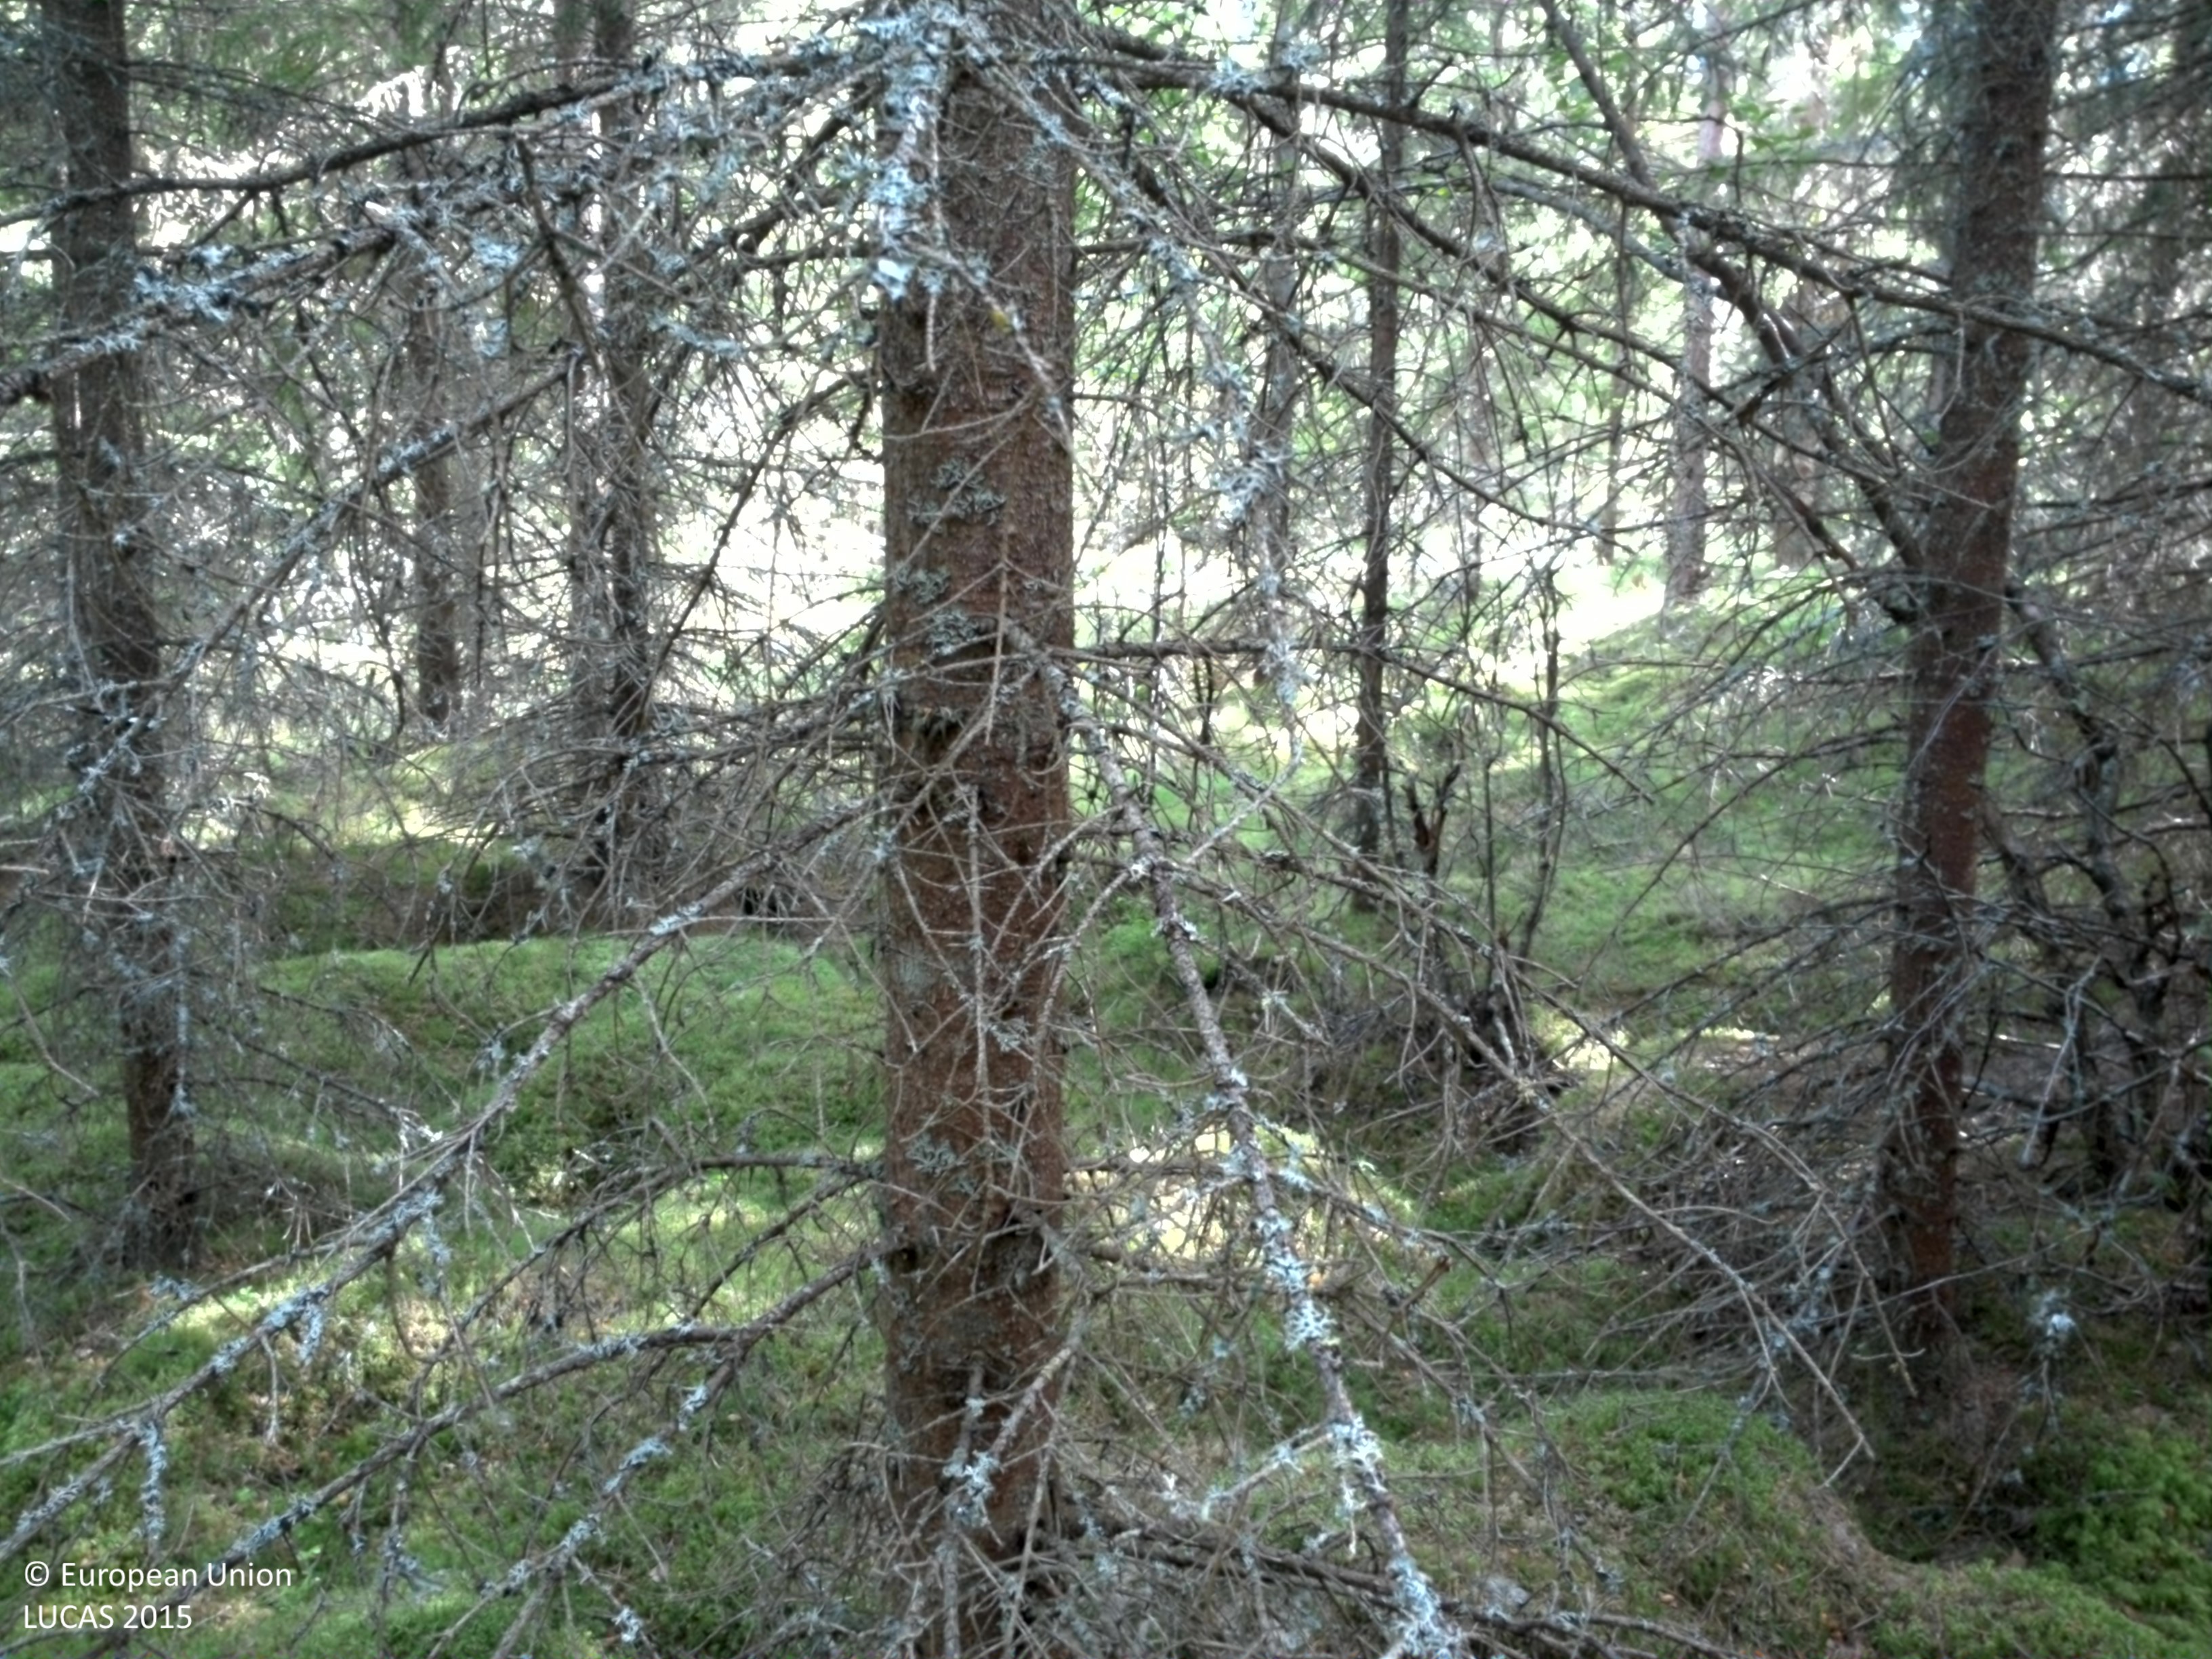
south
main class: Woodland
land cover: Spruce dominated coniferous woodland
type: boreal forest
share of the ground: > 75 %
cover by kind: coniferous forest trees 75 %, lichens and mosses 15 %, broadleaved forest trees 5 %, herbaceous plants 5 %
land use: Forestry
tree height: > 5 m
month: June
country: SE
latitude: 59.5778
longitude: 14.1871
